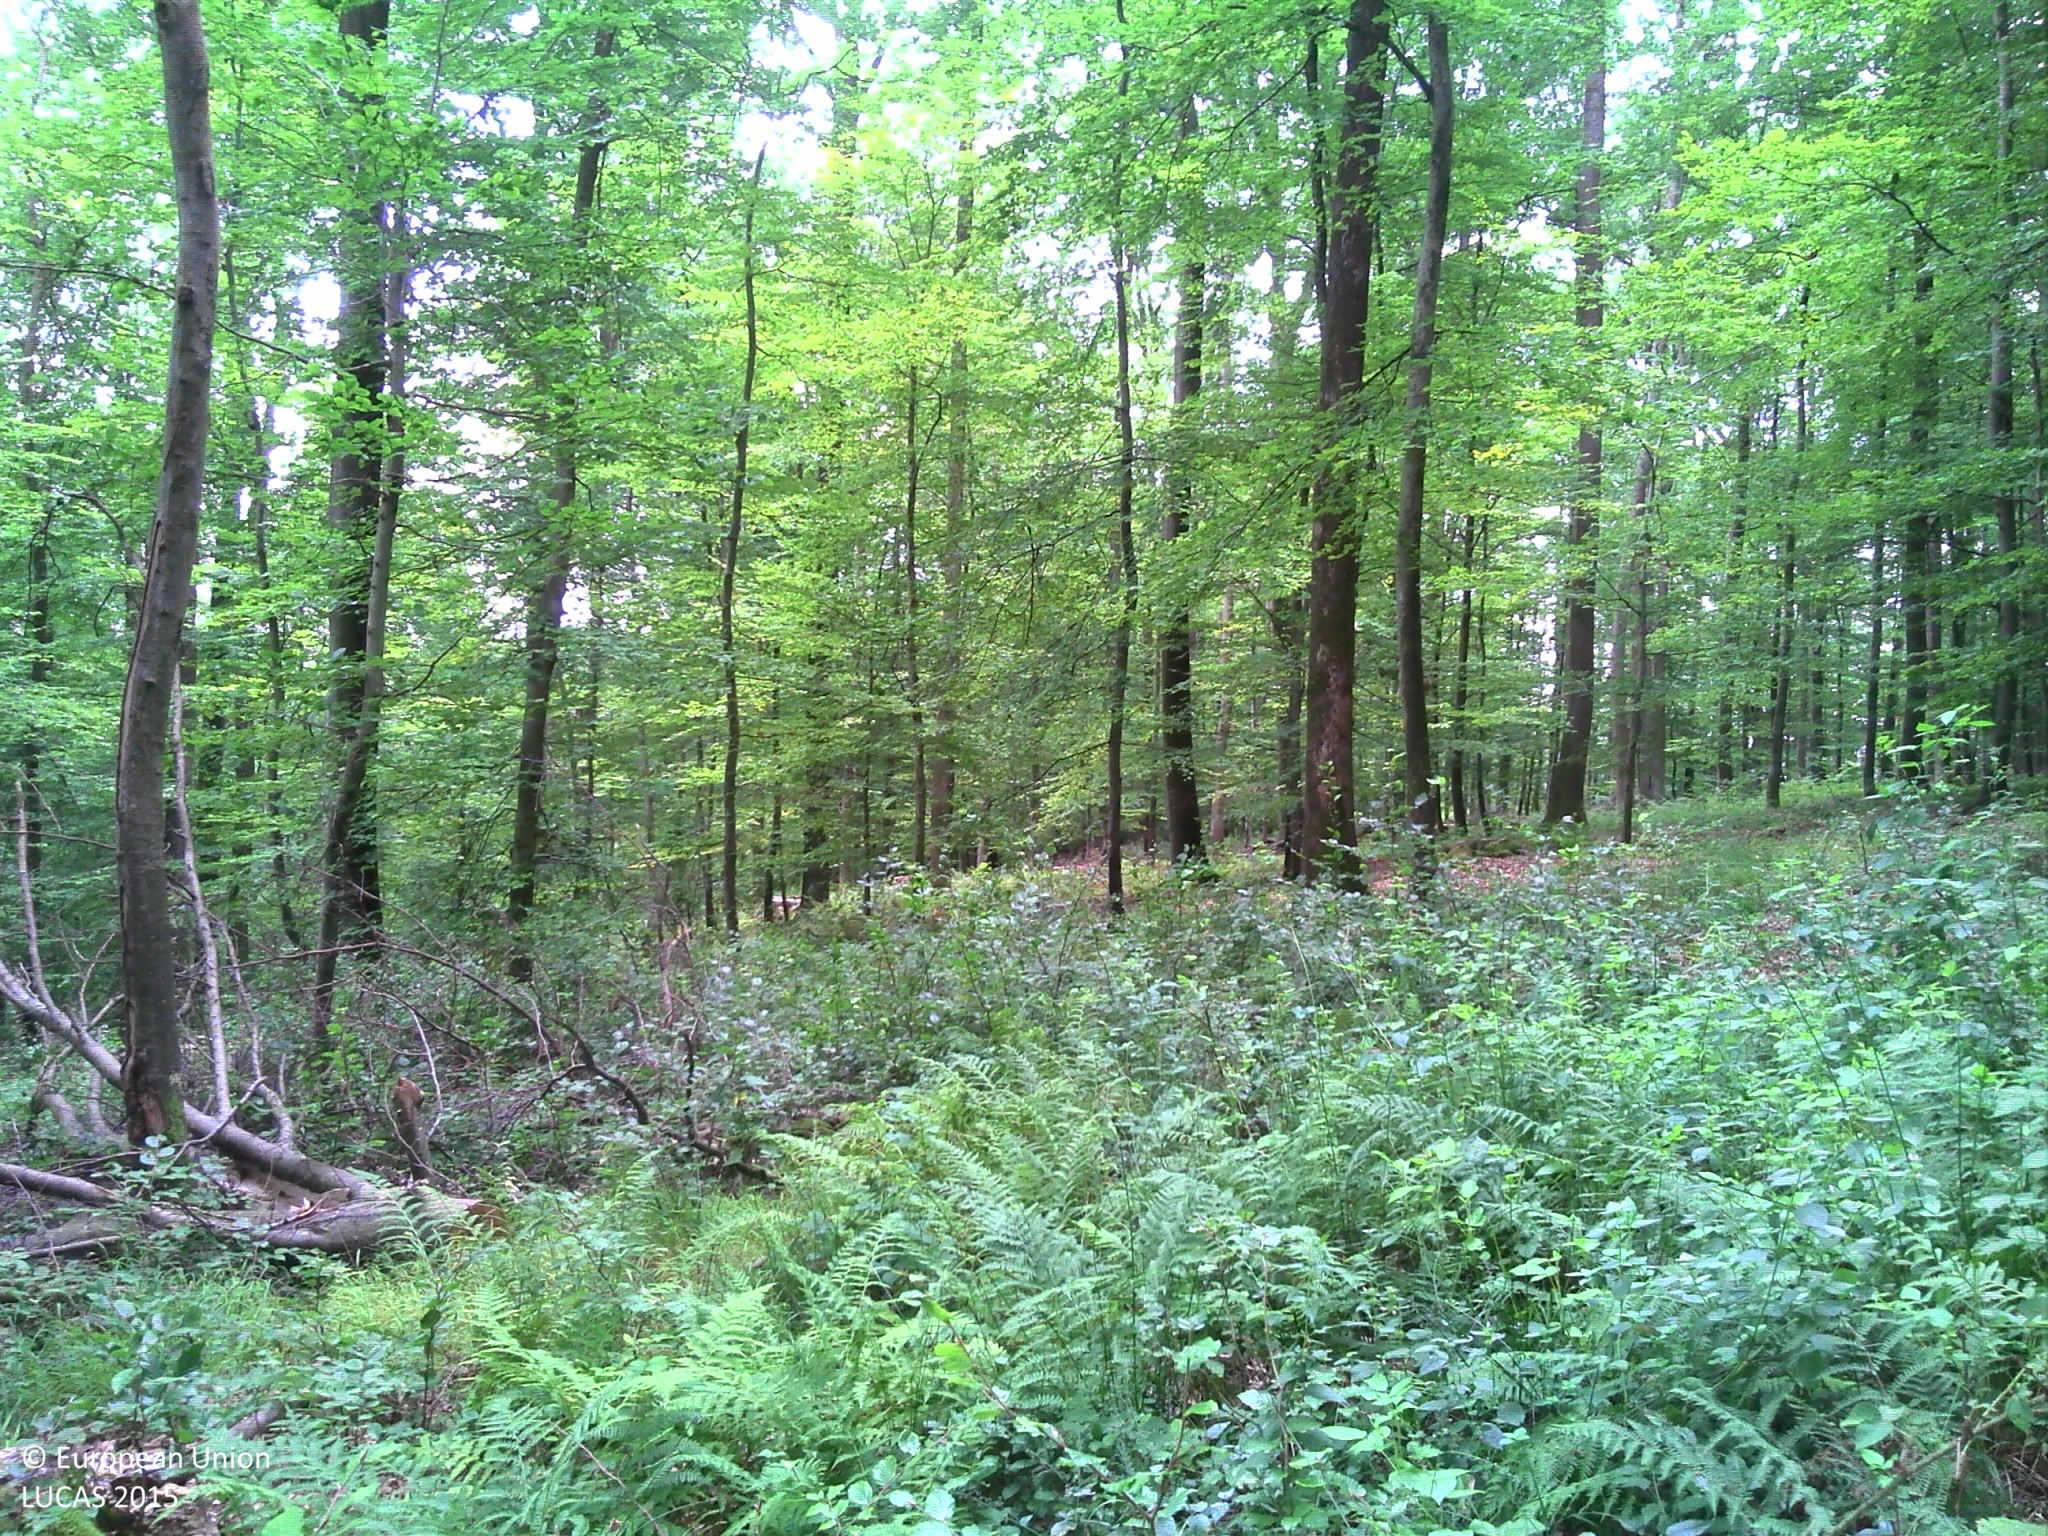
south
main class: Woodland
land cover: Broadleaved woodland
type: beech forest
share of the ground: > 75 %
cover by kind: broadleaved forest trees 90 %, herbaceous plants 10 %
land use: Forestry
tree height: > 5 m
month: August
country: FR
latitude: 48.9177
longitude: 7.6125
